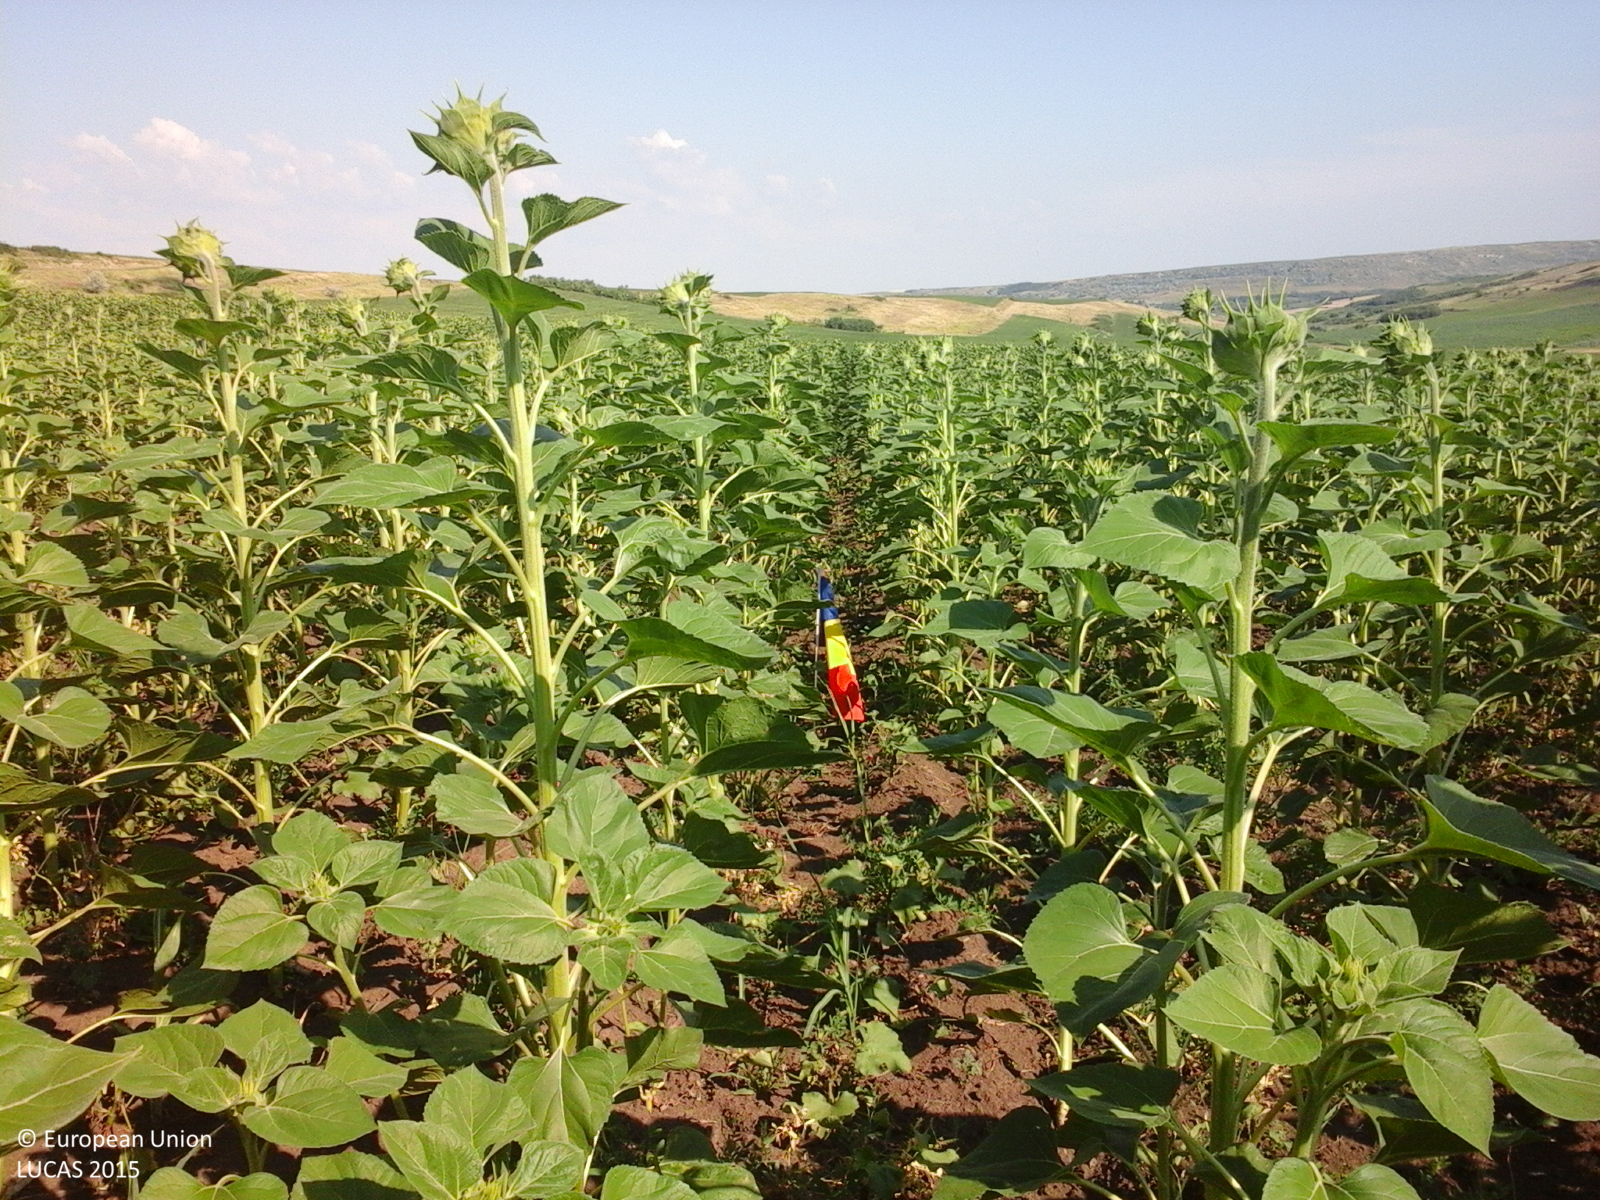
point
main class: Cropland
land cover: Sunflower
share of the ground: 50 - 75 %
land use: Agriculture (excluding fallow land and kitchen gardens)
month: June
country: RO
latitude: 46.8837
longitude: 28.0435
